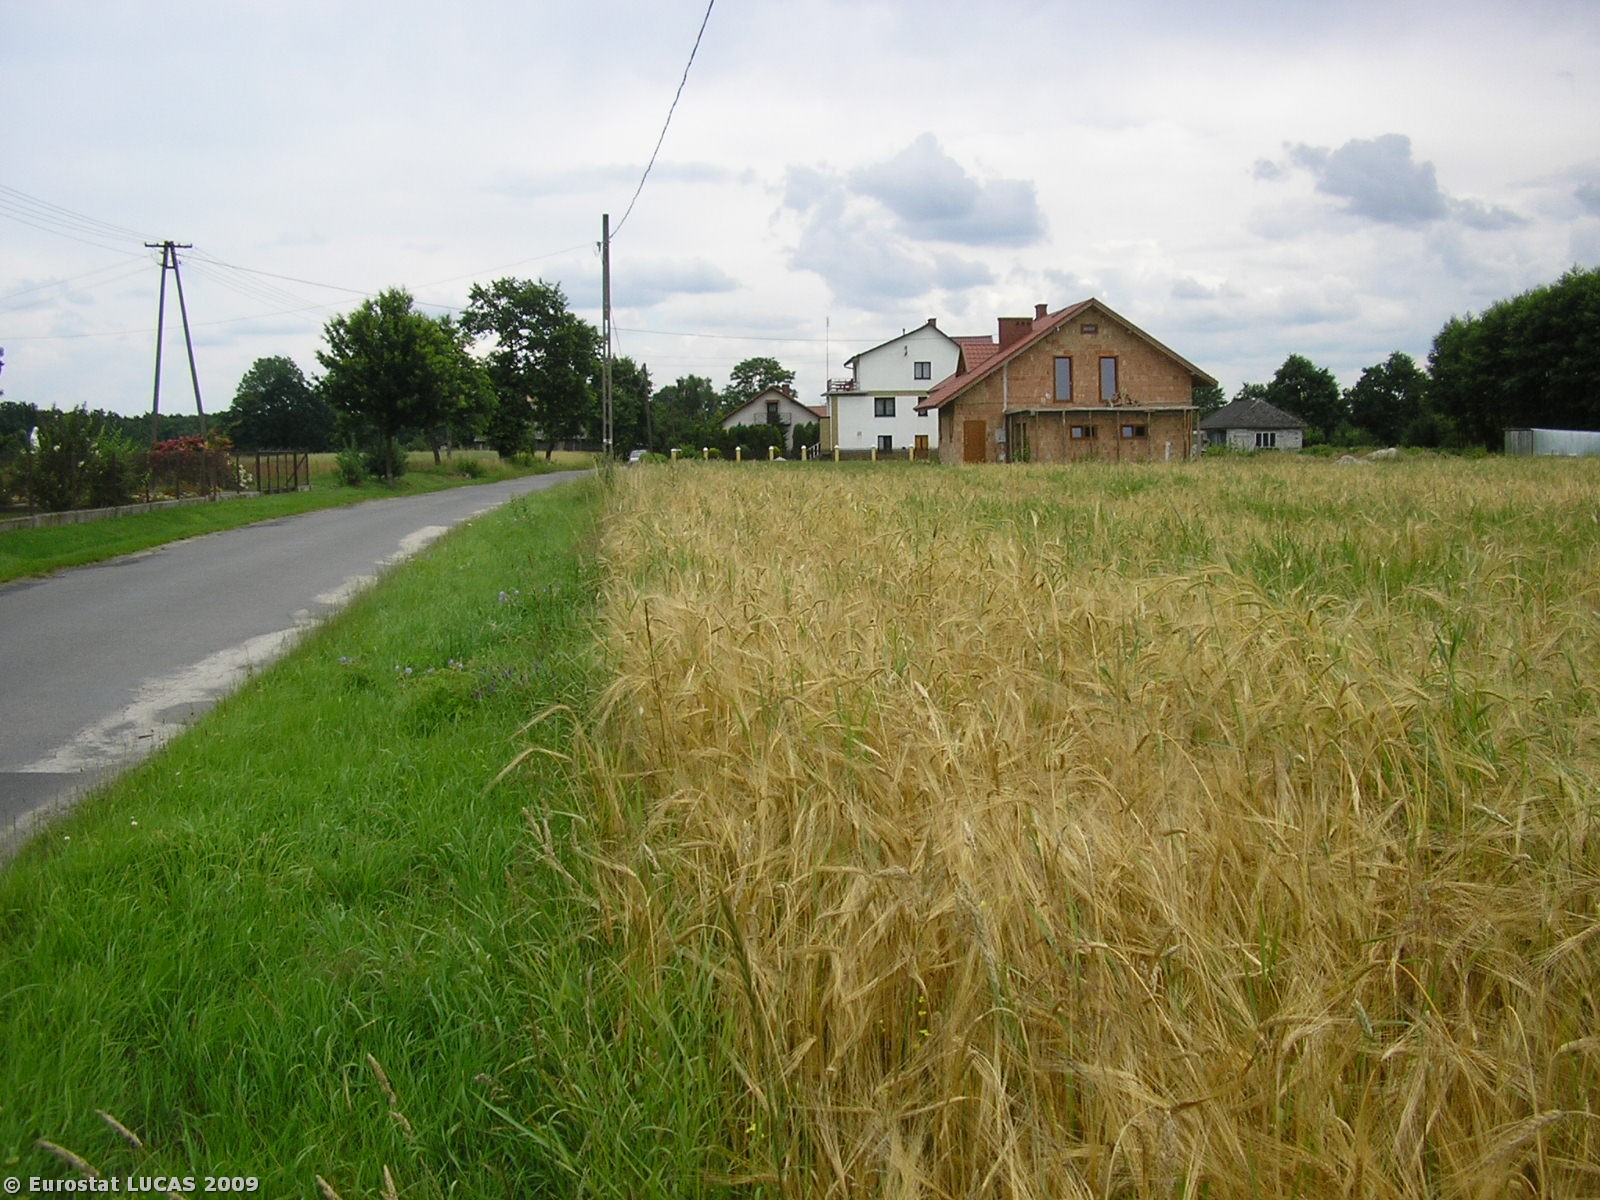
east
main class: Cropland
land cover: Barley
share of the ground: > 75 %
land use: Agriculture (excluding fallow land and kitchen gardens)
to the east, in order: Barley; Grassland without tree/shrub cover; Artificial constructions in urban areas; Grassland without tree/shrub cover; Lines of trees; Fences; Artificial constructions in urban areas; Oats; Potatoes
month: July
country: PL
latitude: 50.1491
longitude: 20.7182
